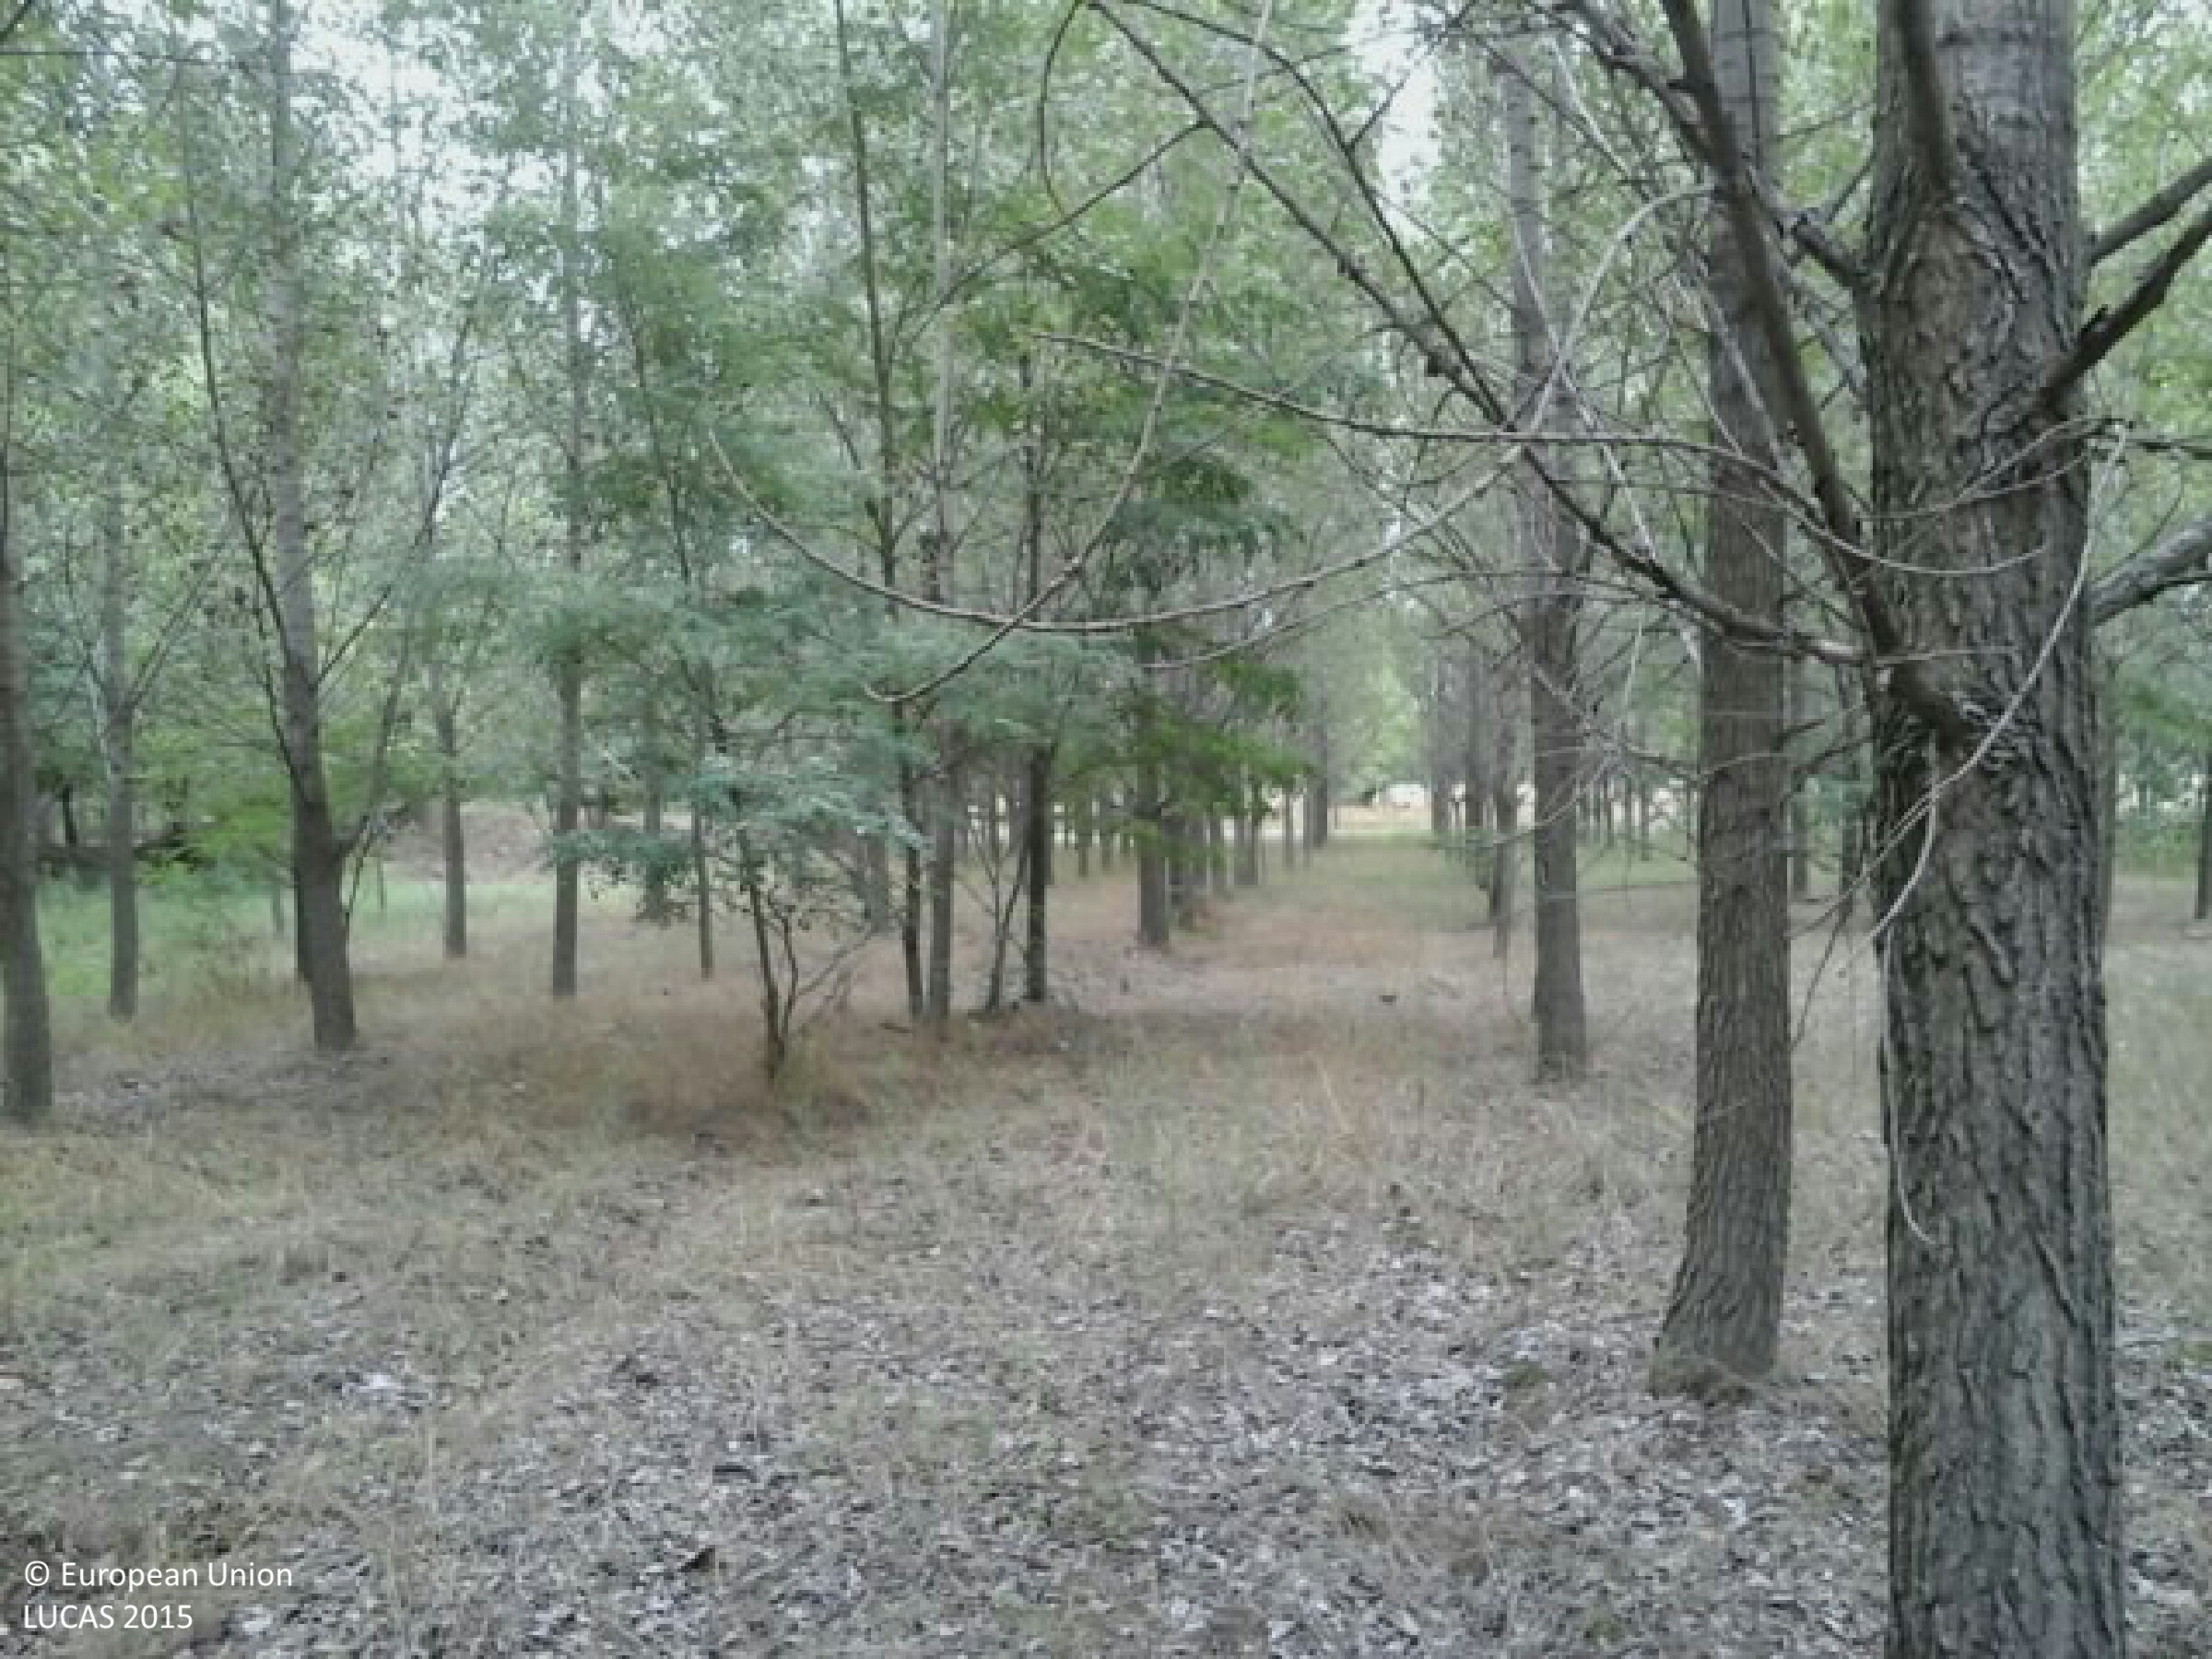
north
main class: Woodland
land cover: Broadleaved woodland
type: mesophytic deciduous forest
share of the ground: > 75 %
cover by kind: broadleaved forest trees 80 %, herbaceous plants 20 %
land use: Forestry
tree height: > 5 m
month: July
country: HU
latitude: 47.1257
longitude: 19.6840
